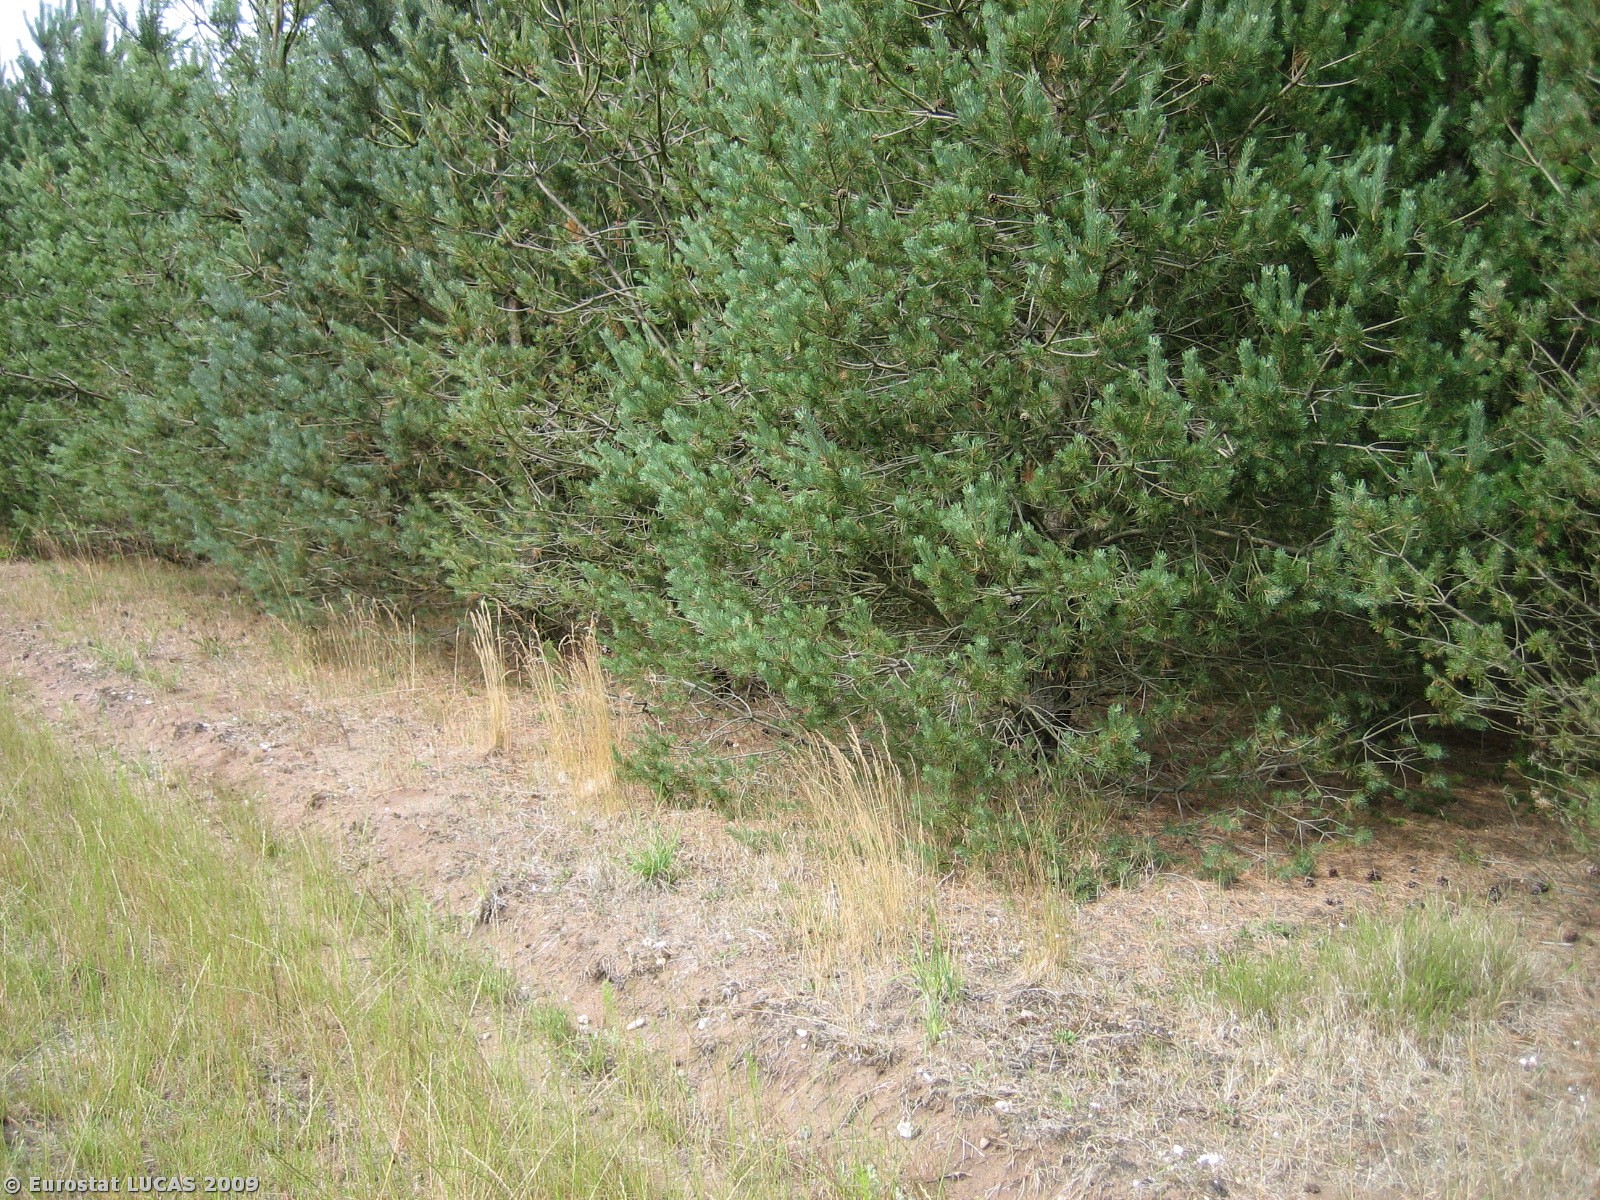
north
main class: Grassland
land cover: Grassland without tree/shrub cover
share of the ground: 50 - 75 %
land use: Forestry
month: July
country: DK
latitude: 55.8044
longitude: 8.7728
